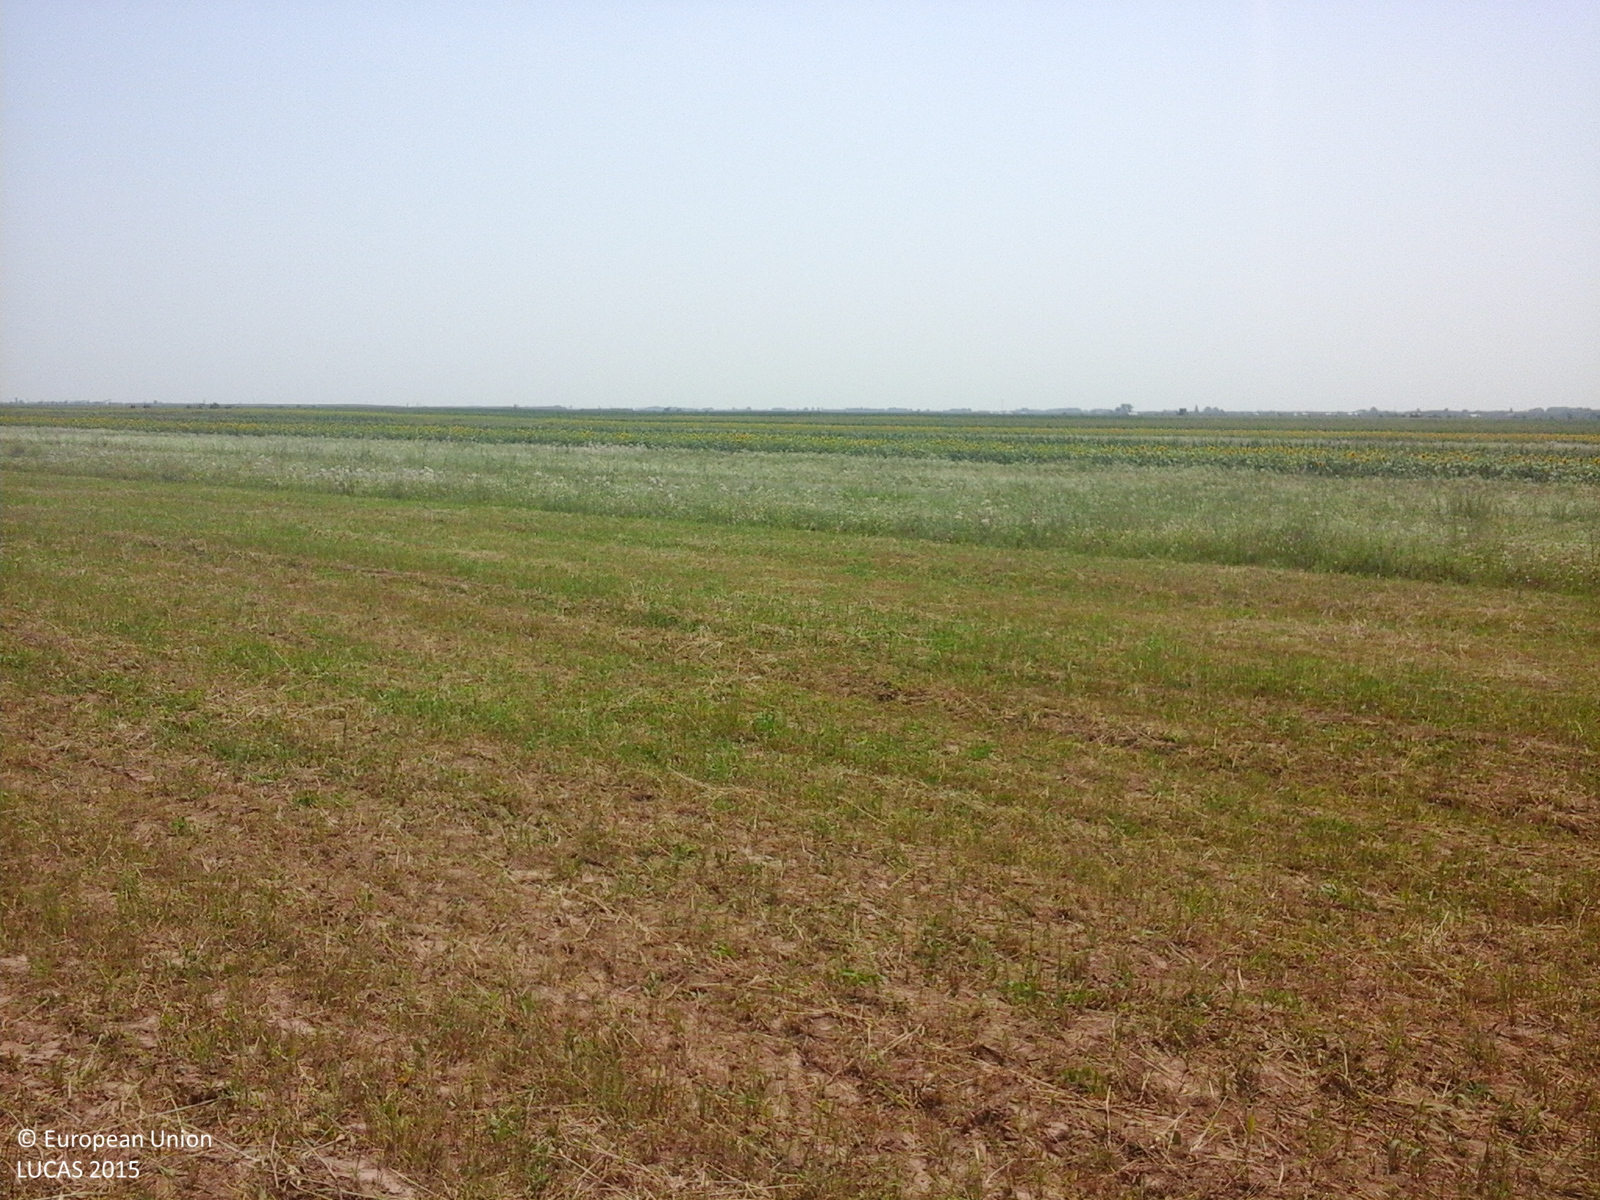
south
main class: Cropland
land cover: Oats
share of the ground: < 10 %
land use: Agriculture (excluding fallow land and kitchen gardens)
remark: Harvested field
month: July
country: RO
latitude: 44.5384
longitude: 25.7153
